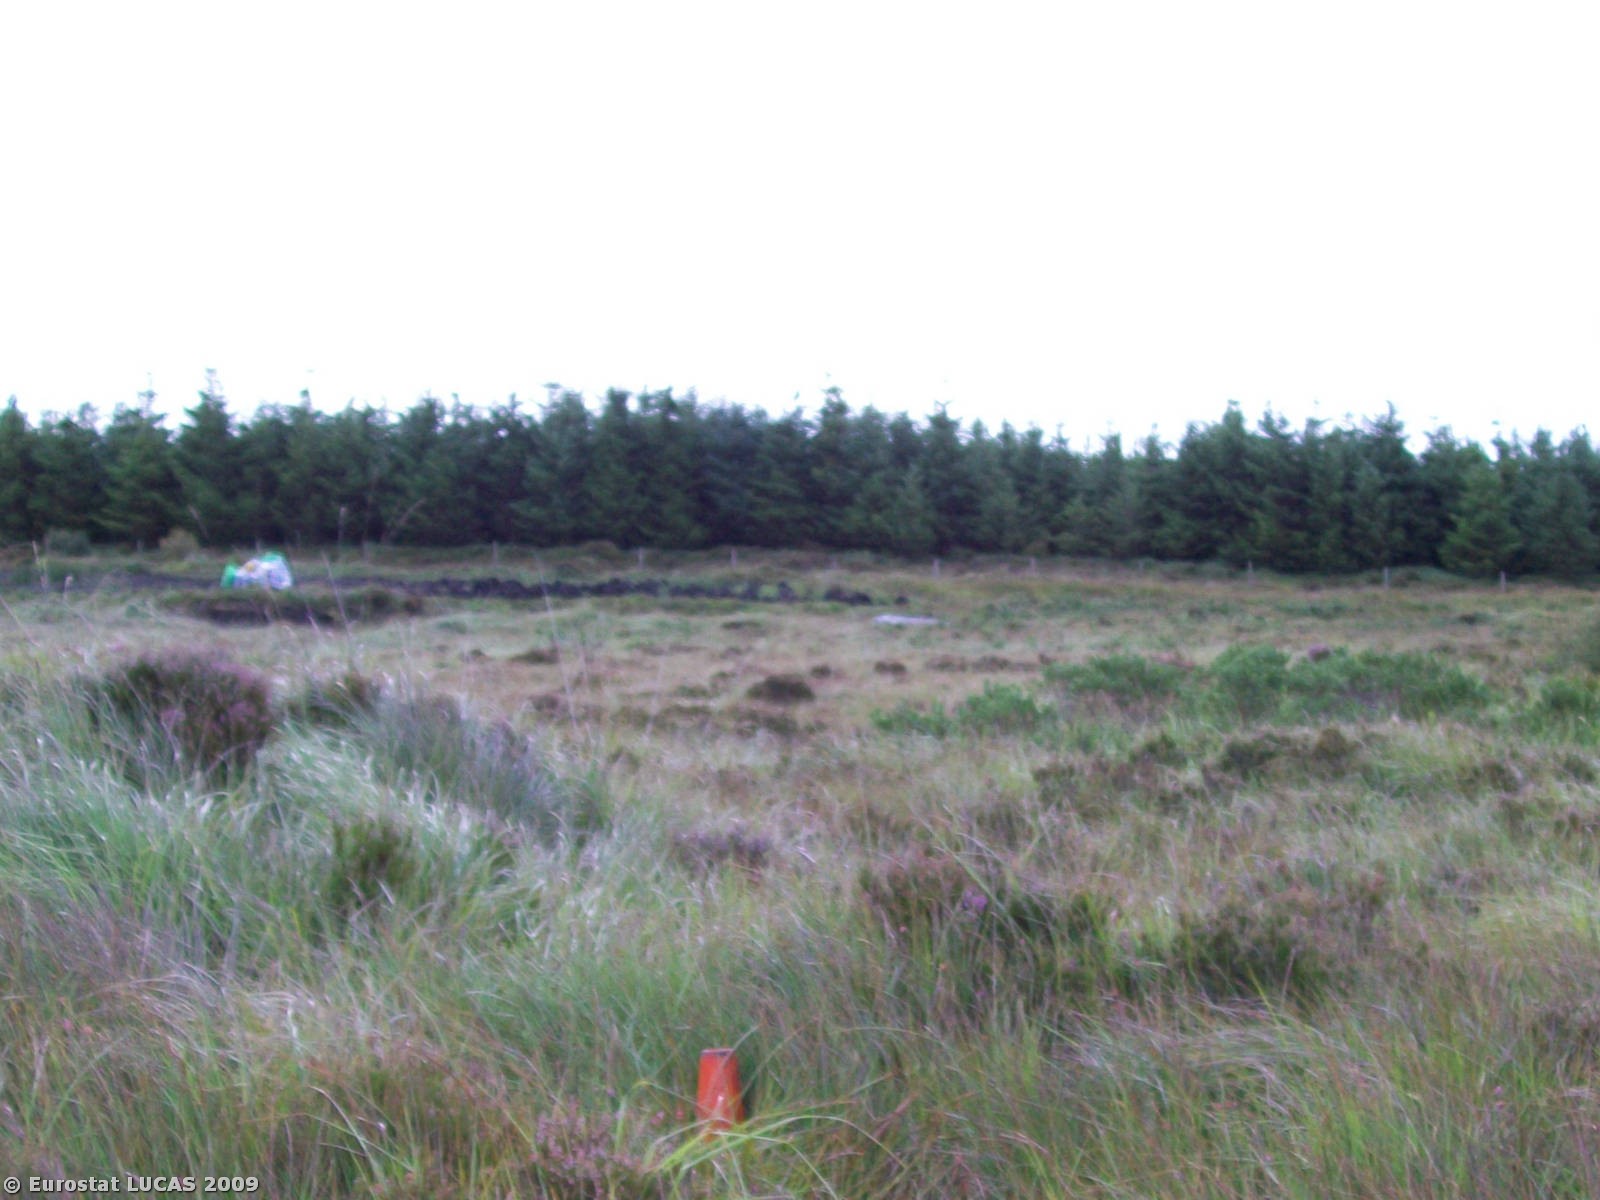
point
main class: Wetlands
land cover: Peatbogs
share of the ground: > 75 %
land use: Mining and quarrying
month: August
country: IE
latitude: 52.7554
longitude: -9.1705
